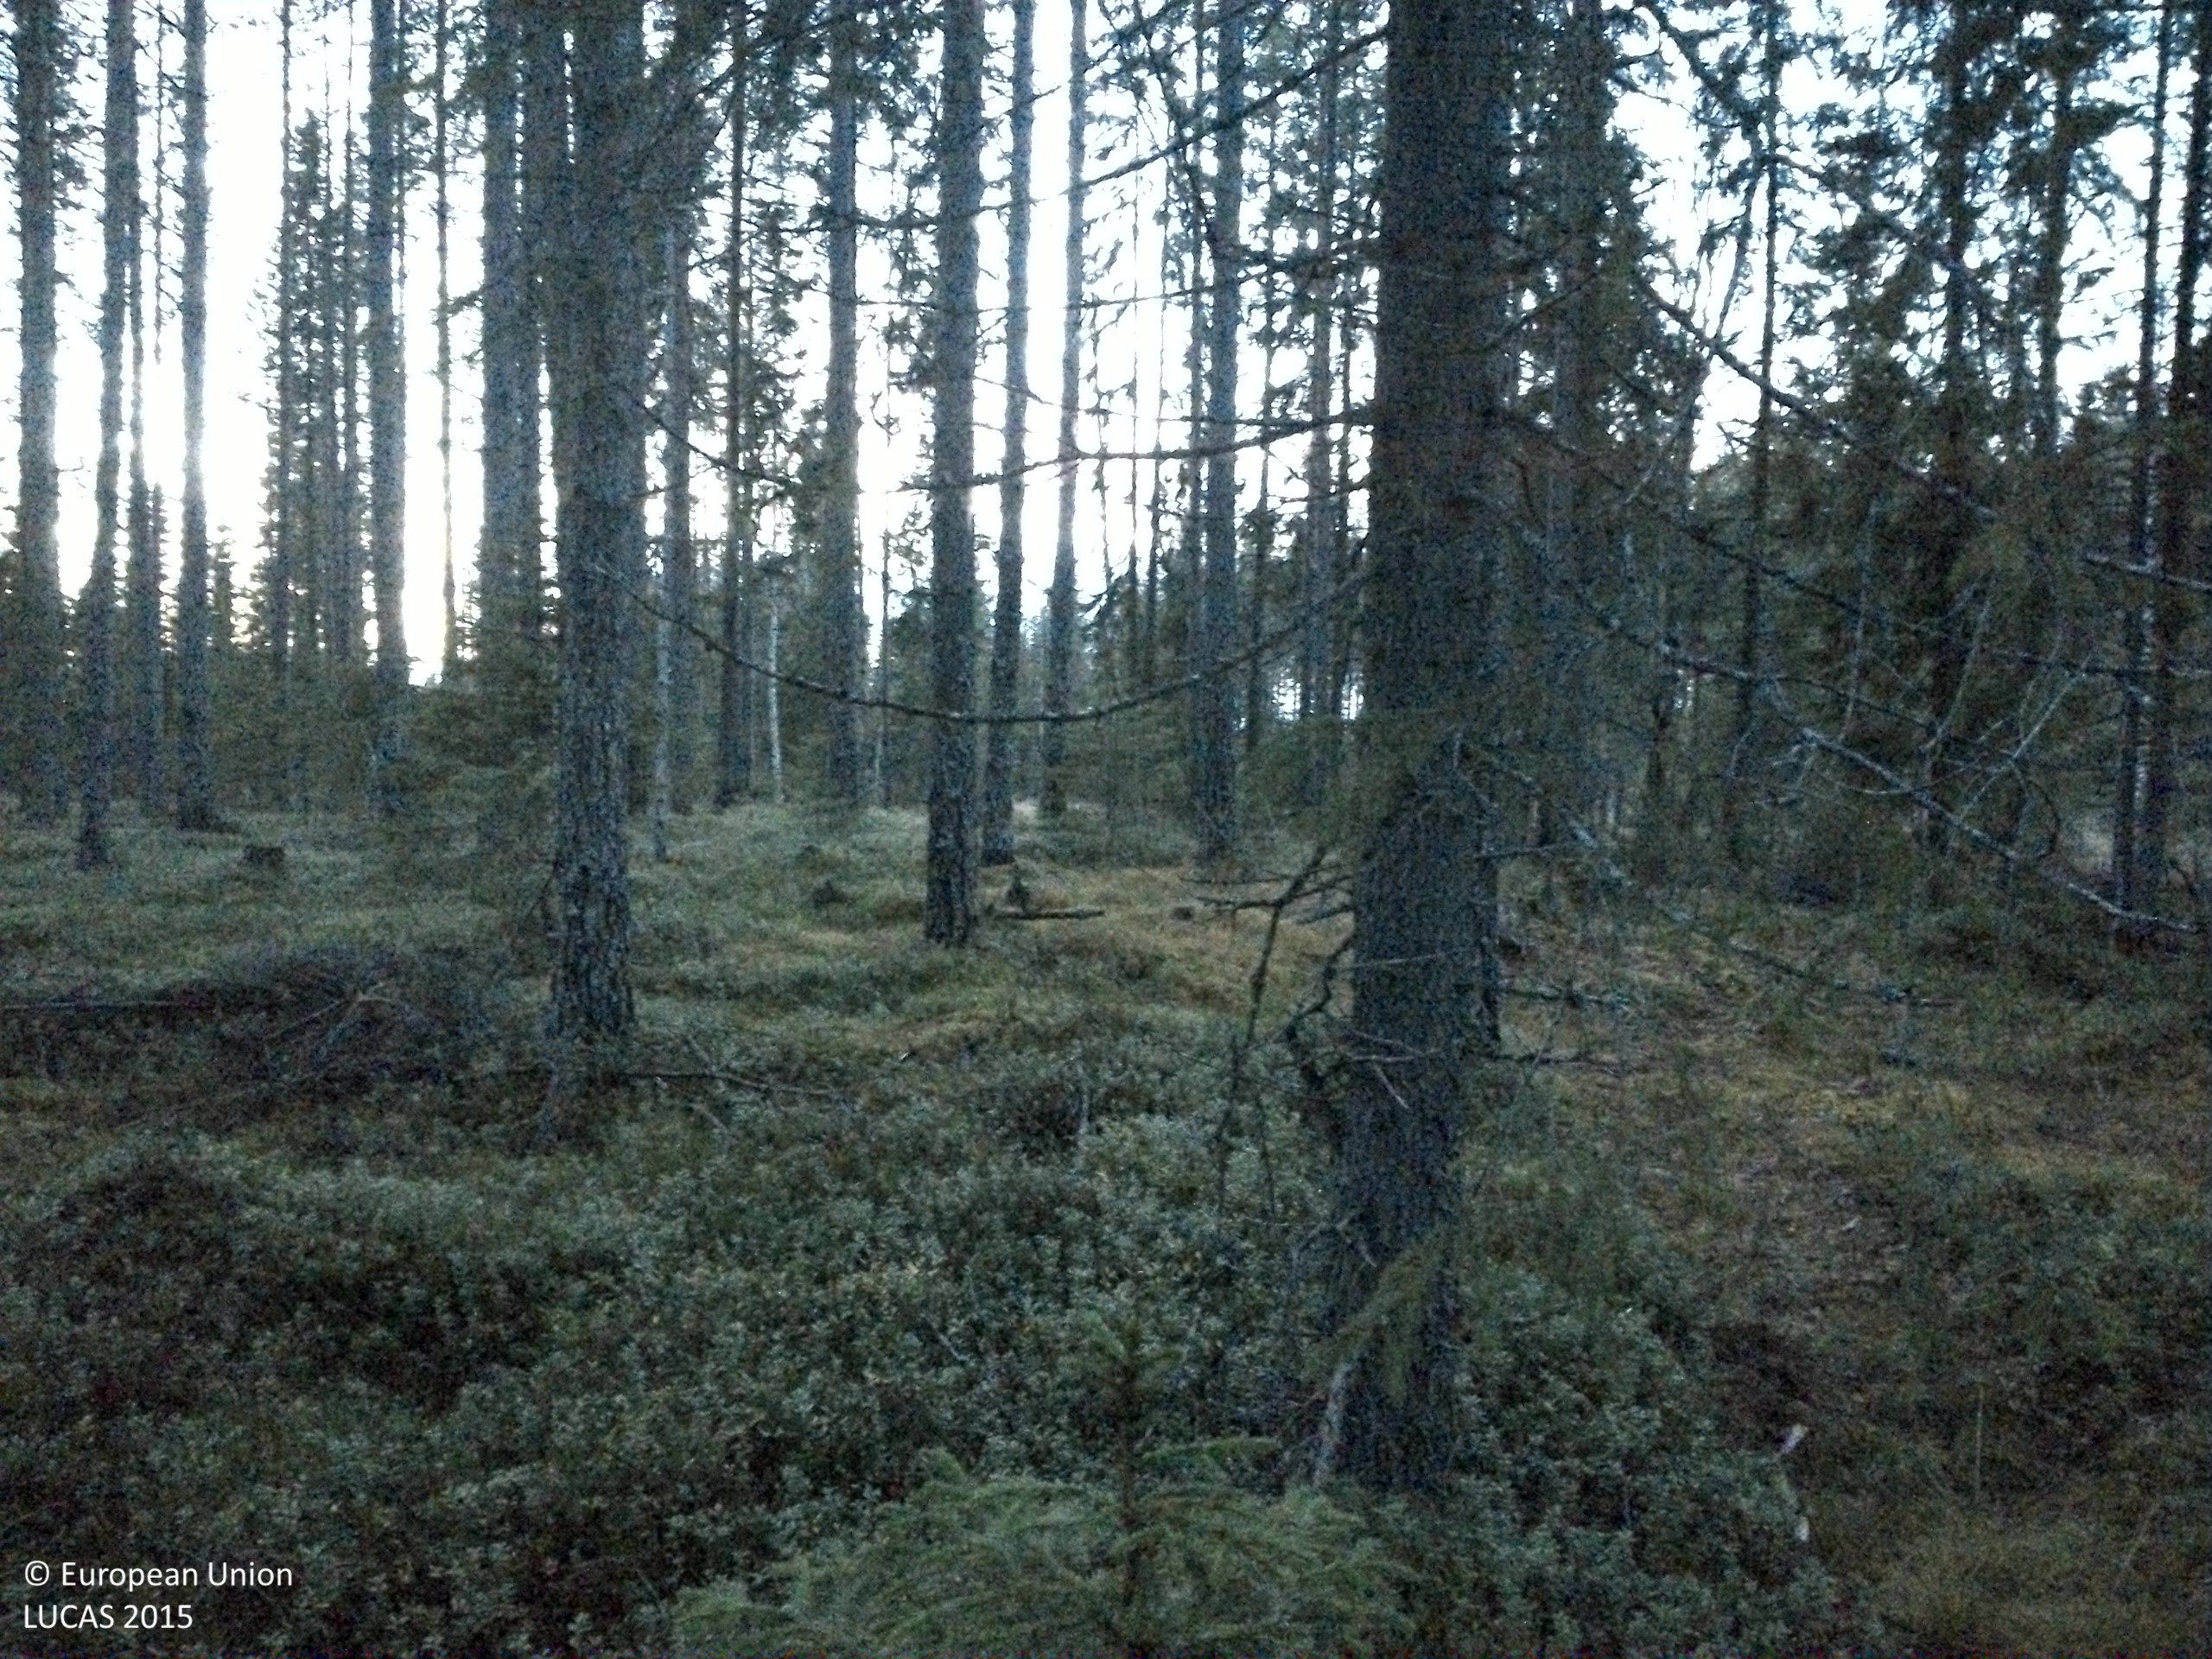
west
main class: Woodland
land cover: Other coniferous woodland
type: boreal forest
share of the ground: 50 - 75 %
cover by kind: coniferous forest trees 50 %, shrubs 30 %, lichens and mosses 15 %, broadleaved forest trees 5 %
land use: Forestry
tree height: > 5 m
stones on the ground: 10 - 25 %
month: October
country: SE
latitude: 63.7789
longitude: 15.4713
